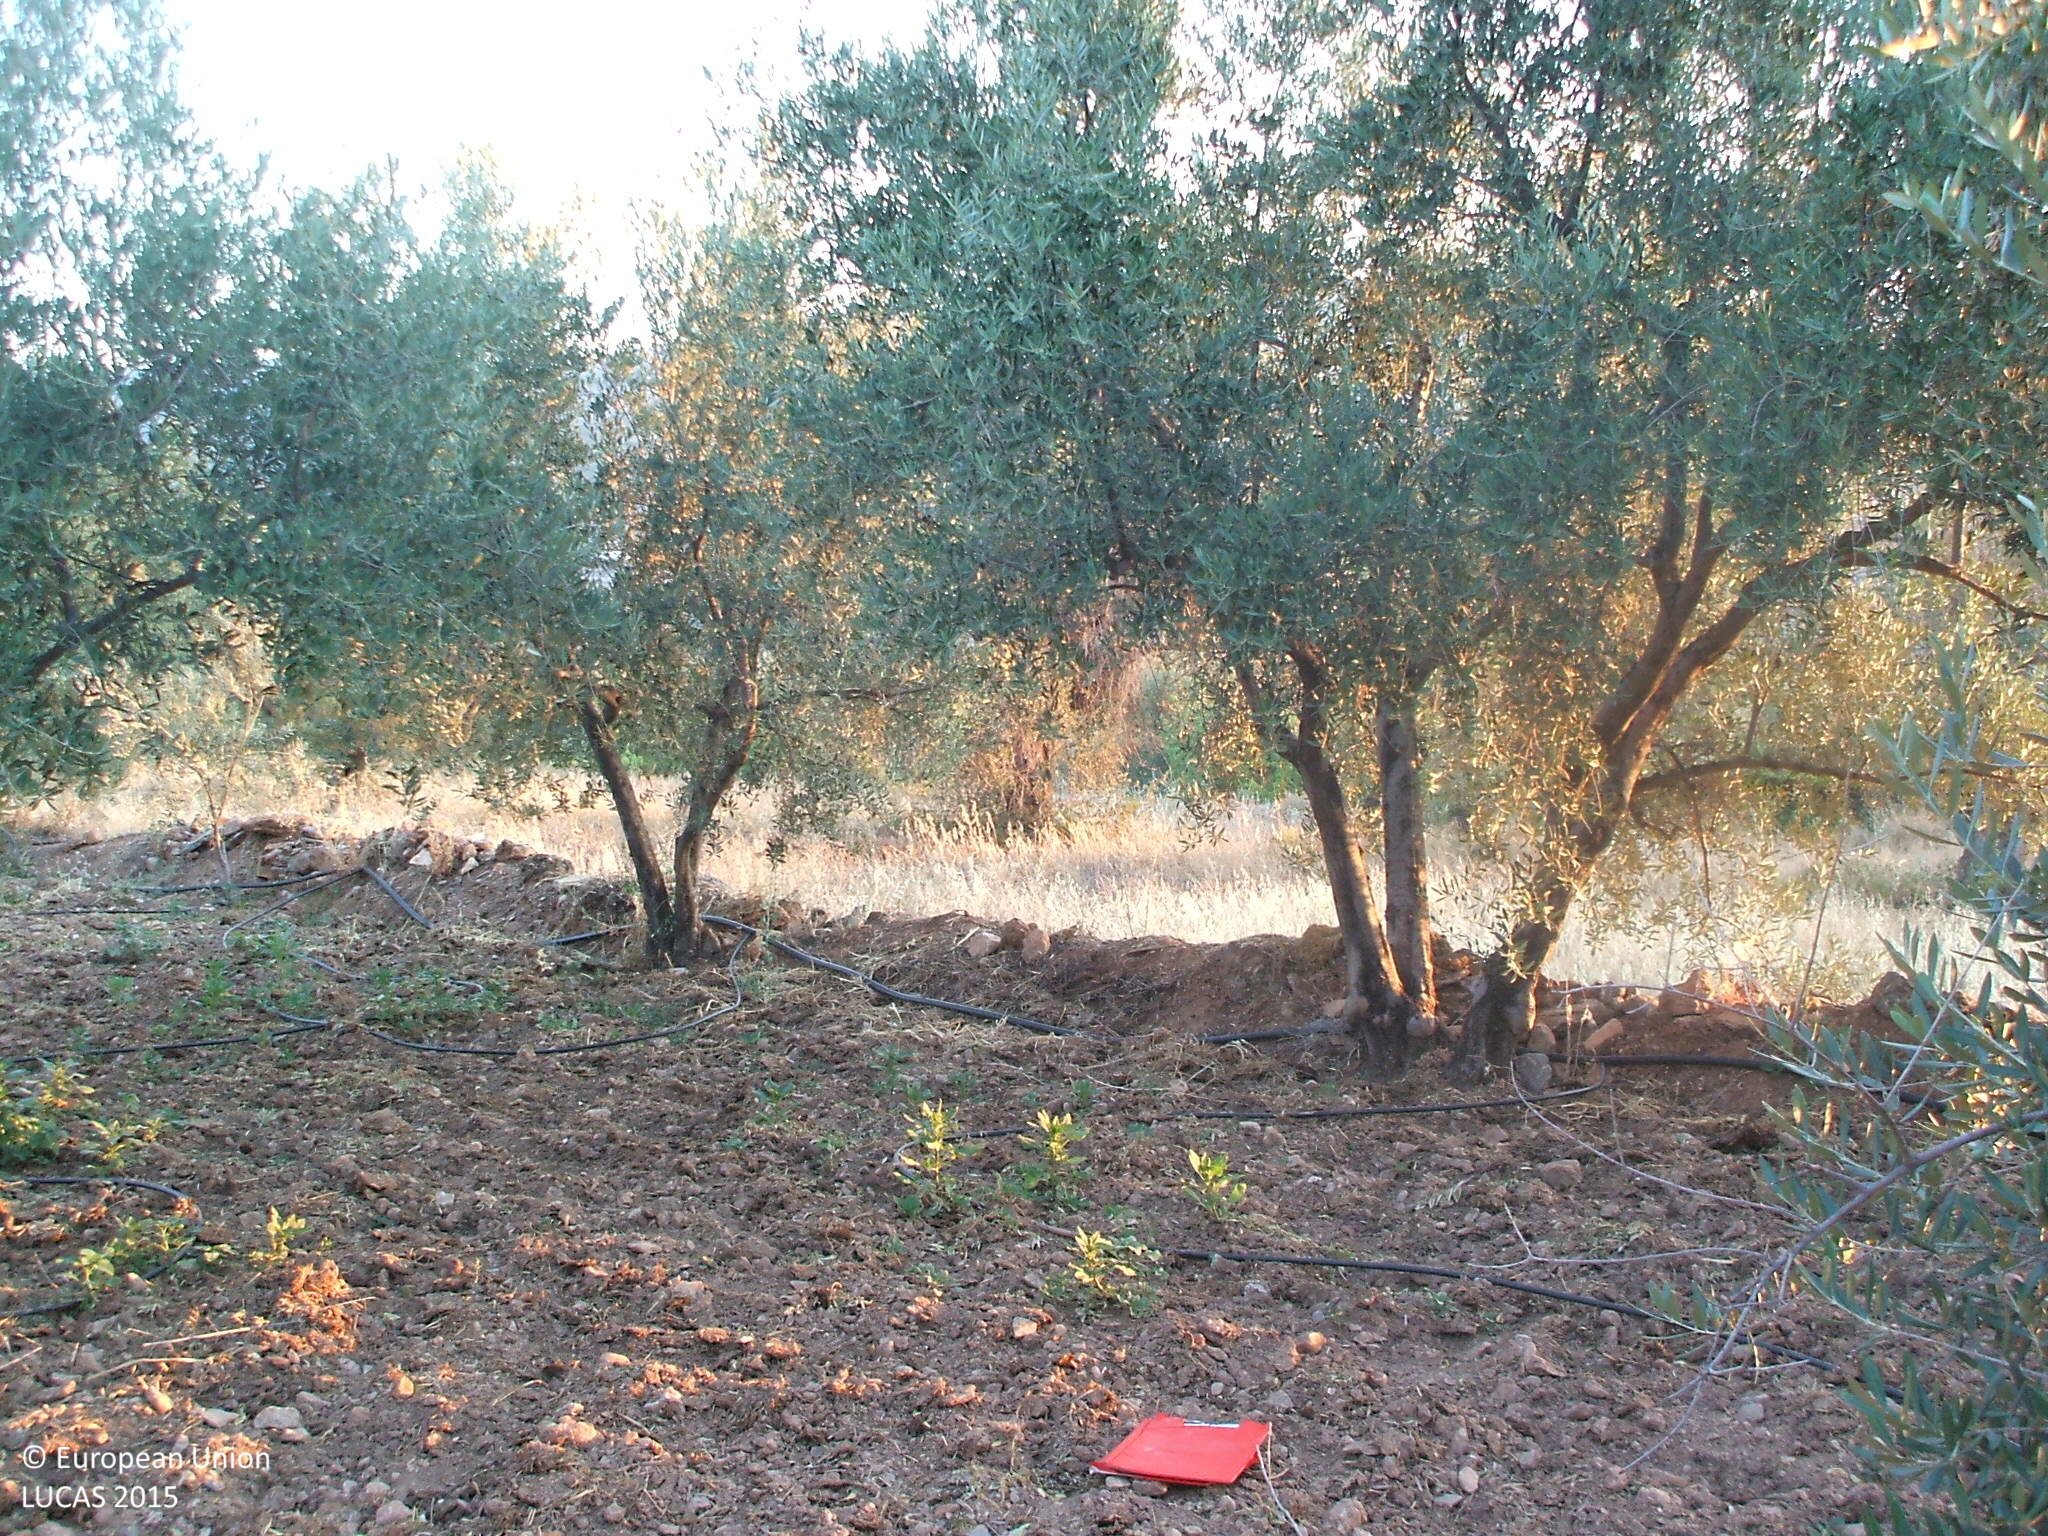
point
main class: Cropland
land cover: Olive groves
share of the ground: 25 - 50 %
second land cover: Other bare soil
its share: > 75 %
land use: Agriculture (excluding fallow land and kitchen gardens)
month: July
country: ES
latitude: 36.9797
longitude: -2.8654
